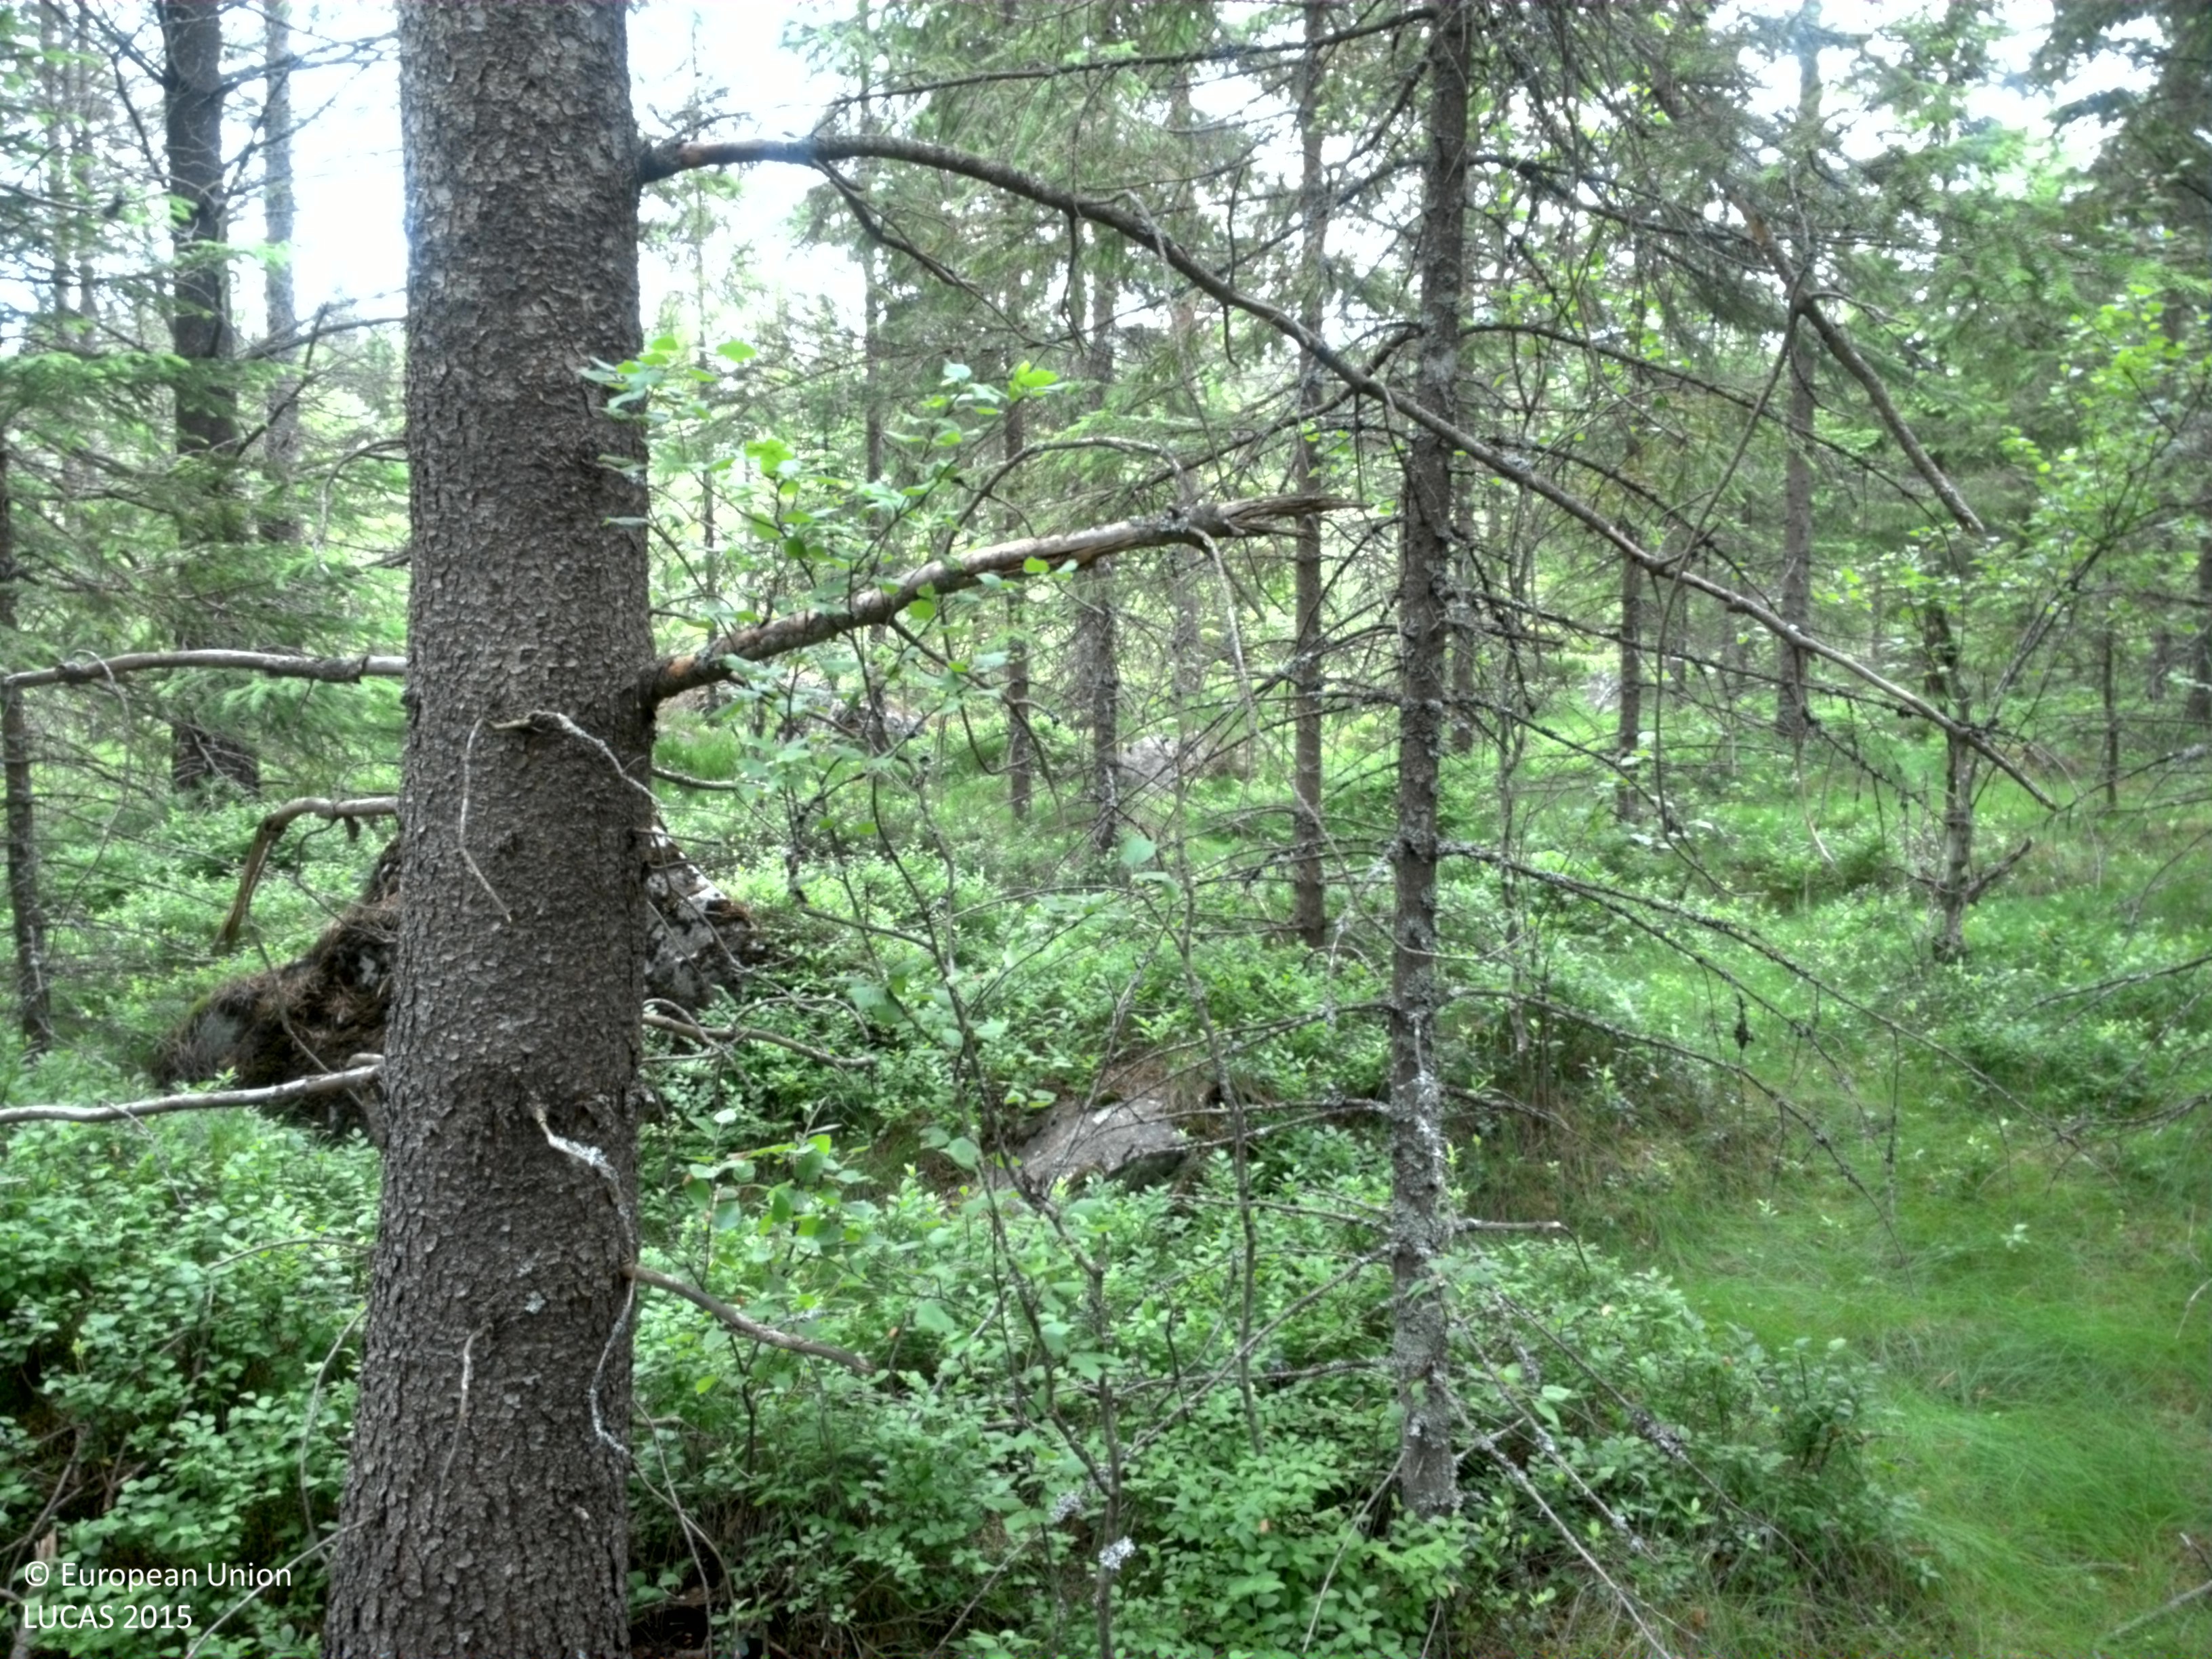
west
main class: Woodland
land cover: Spruce dominated mixed woodland
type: boreal forest
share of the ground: 50 - 75 %
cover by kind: coniferous forest trees 50 %, broadleaved forest trees 20 %, shrubs 10 %, herbaceous plants 10 %, lichens and mosses 5 %, consolidated bare surface 5 %
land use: Forestry
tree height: > 5 m
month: July
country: SE
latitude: 59.5285
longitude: 14.6051
